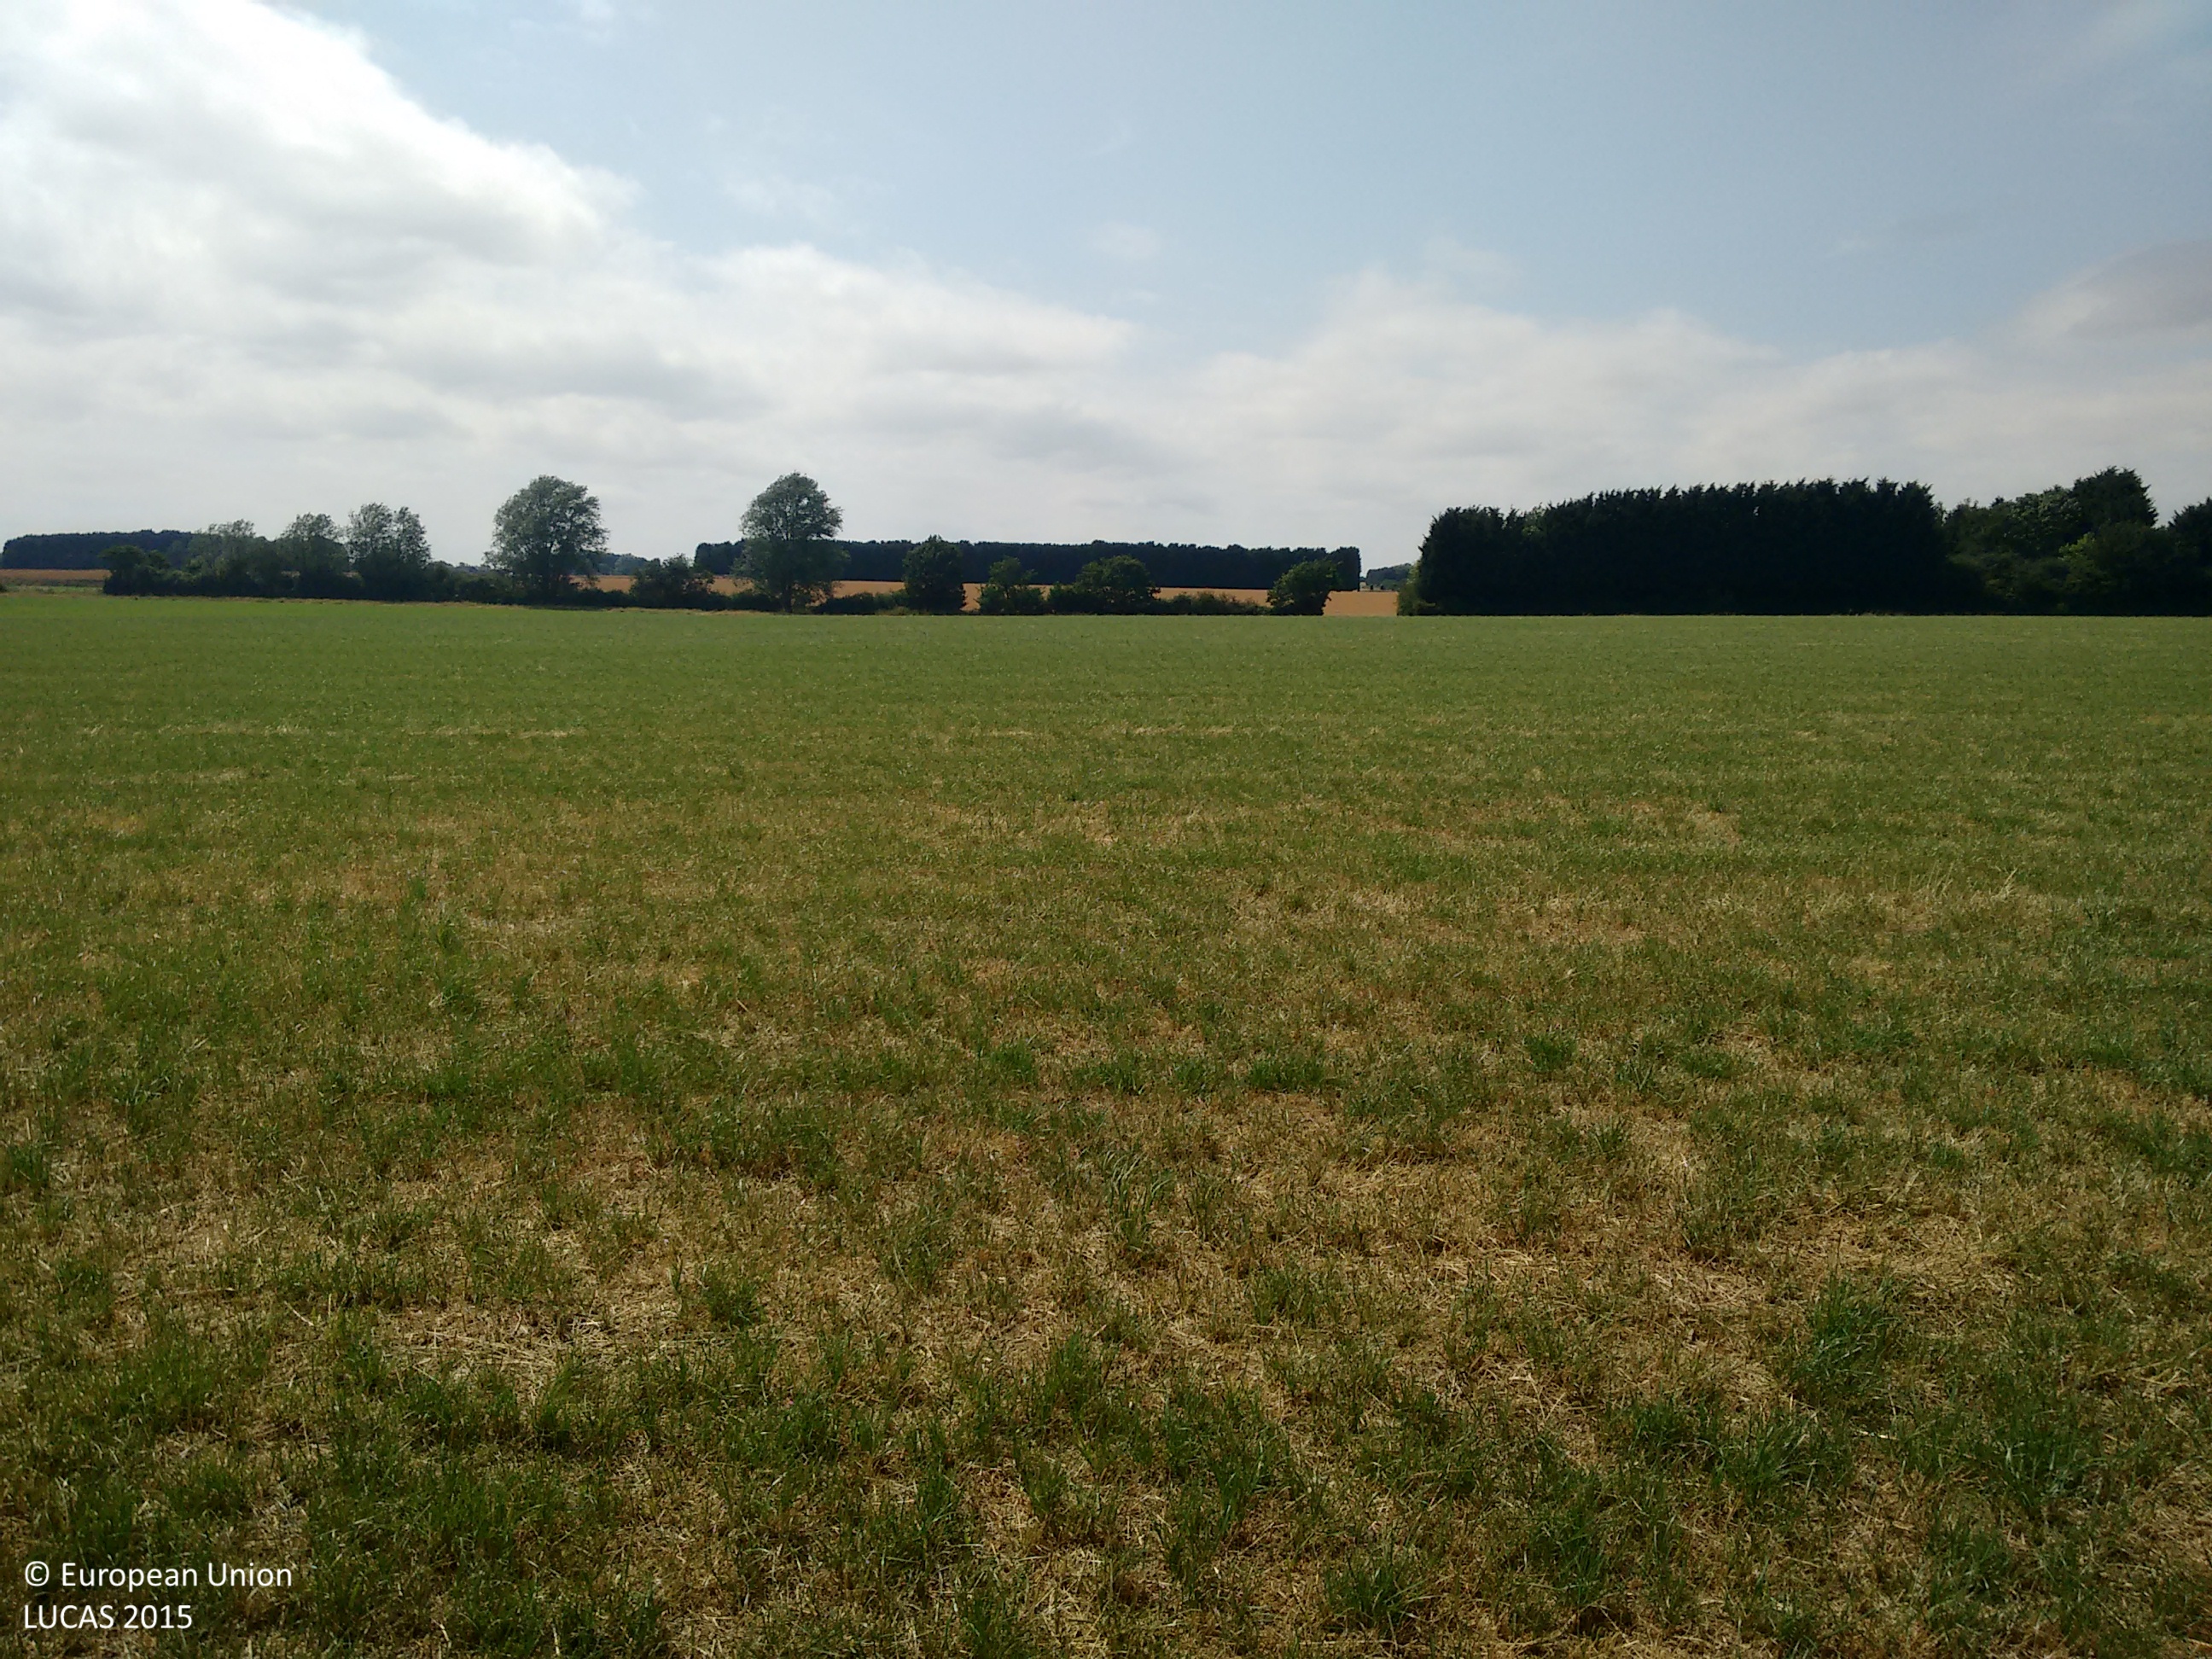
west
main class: Cropland
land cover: Temporary grasslands
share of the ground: > 75 %
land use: Agriculture (excluding fallow land and kitchen gardens)
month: July
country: GB
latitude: 51.7116
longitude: 0.3463
